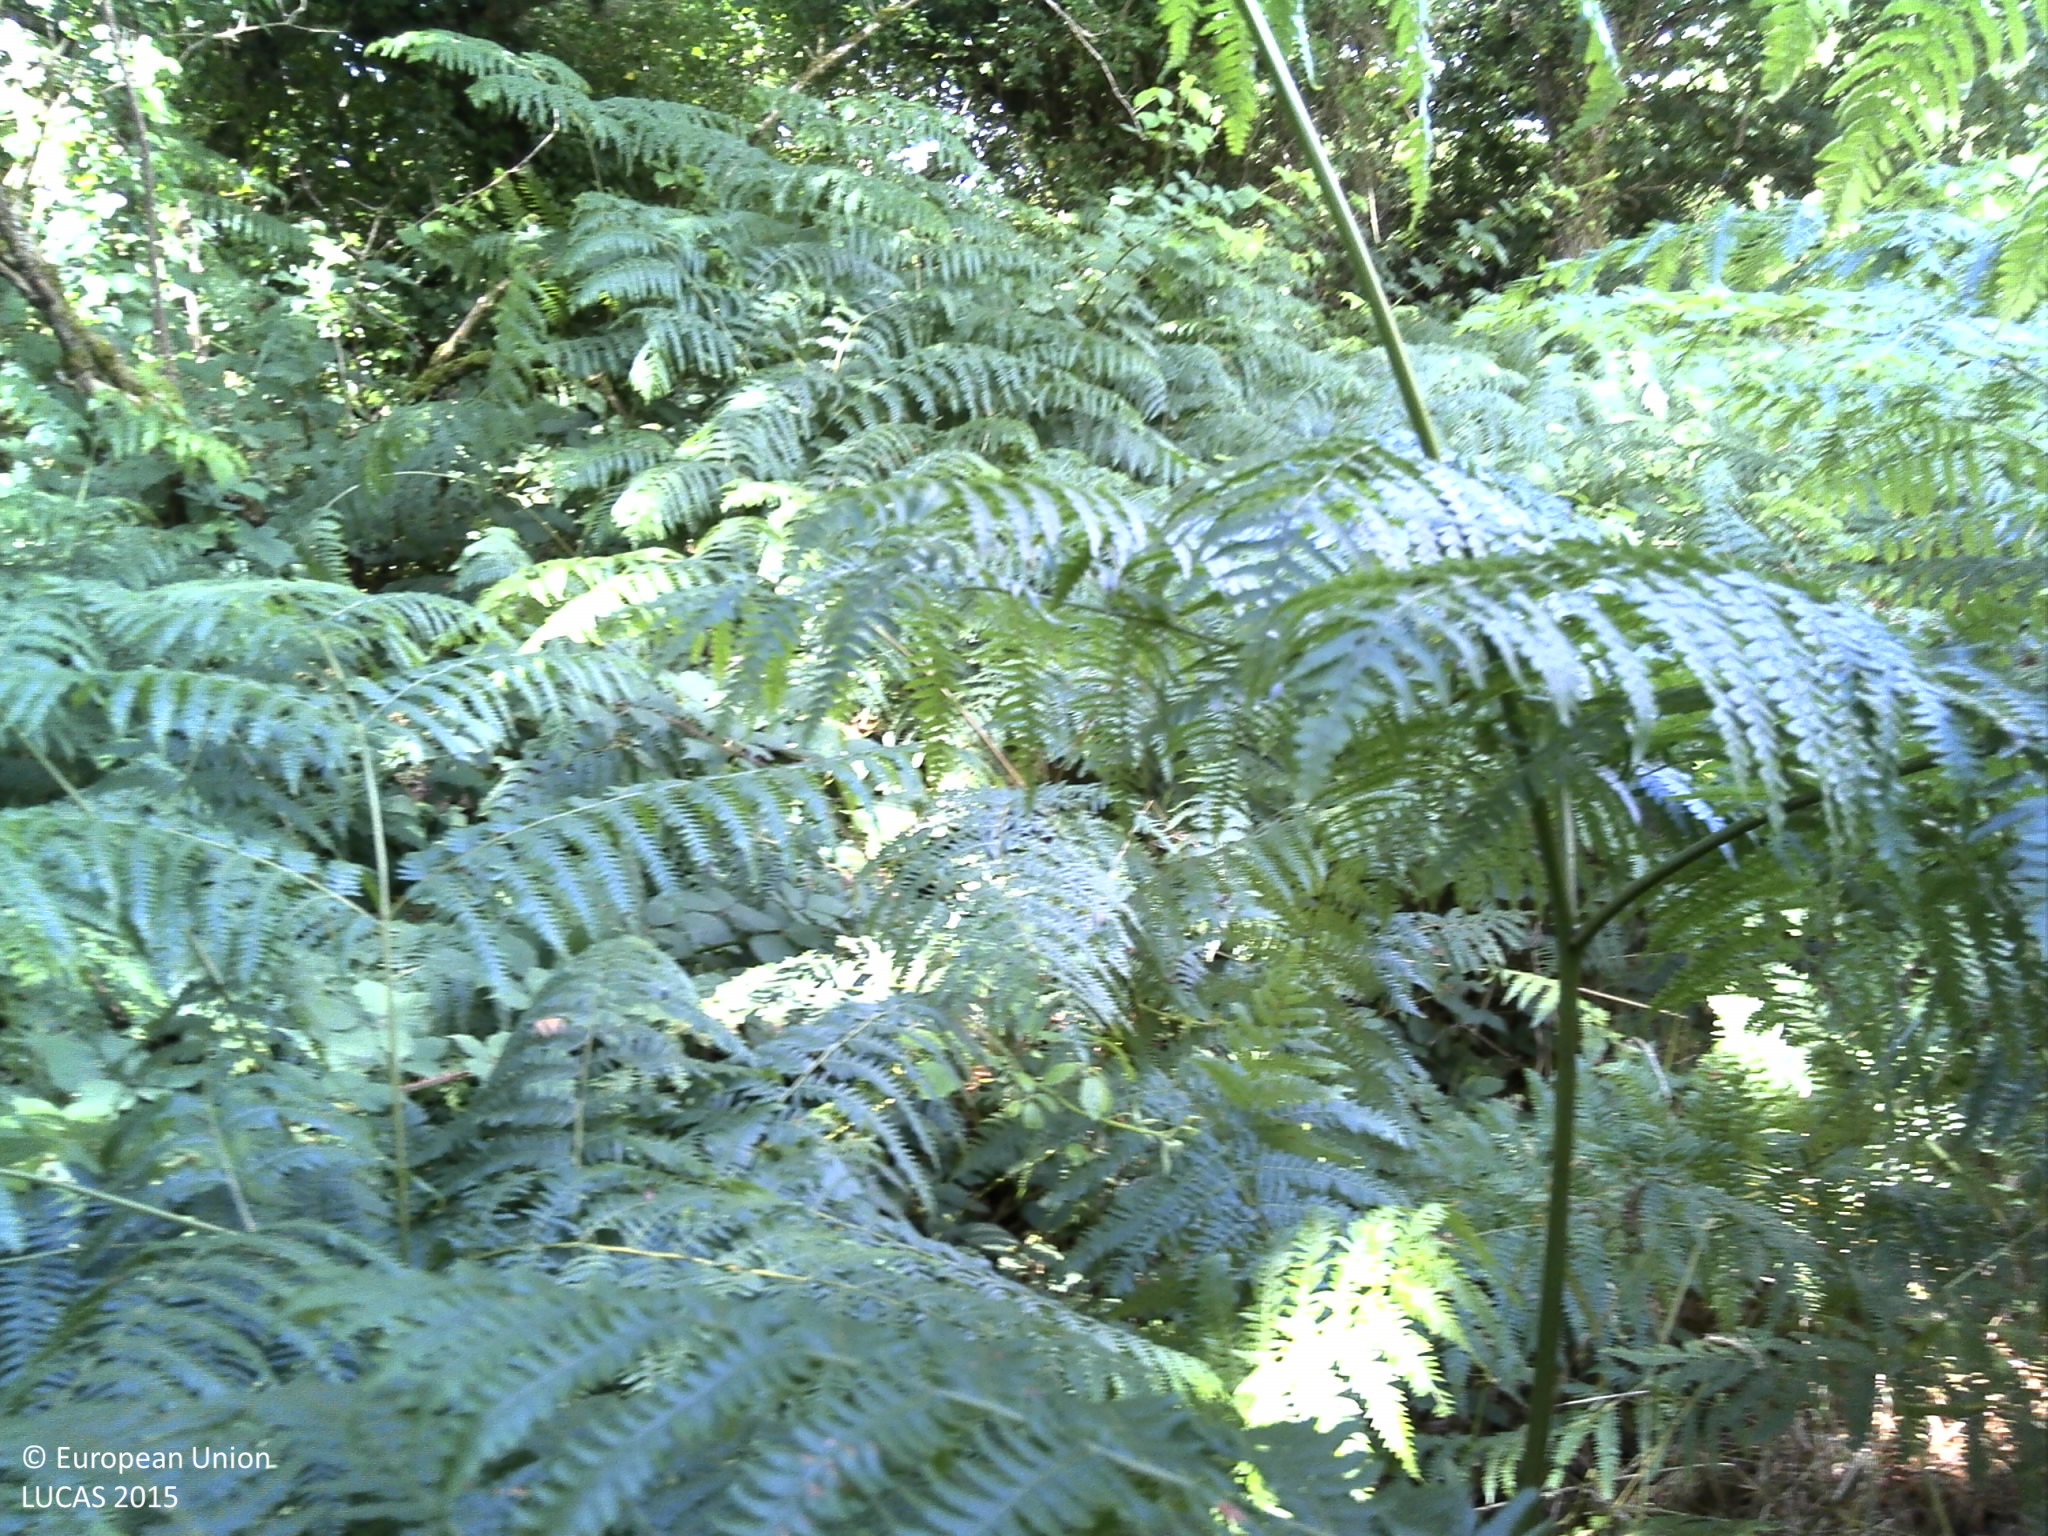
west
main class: Woodland
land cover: Broadleaved woodland
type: acidophilous oak and oak-birch forest
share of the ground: > 75 %
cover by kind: broadleaved forest trees 90 %, shrubs 5 %, herbaceous plants 5 %
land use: Semi-natural and natural areas not in use
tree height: > 5 m
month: July
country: FR
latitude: 48.3137
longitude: -3.6874
